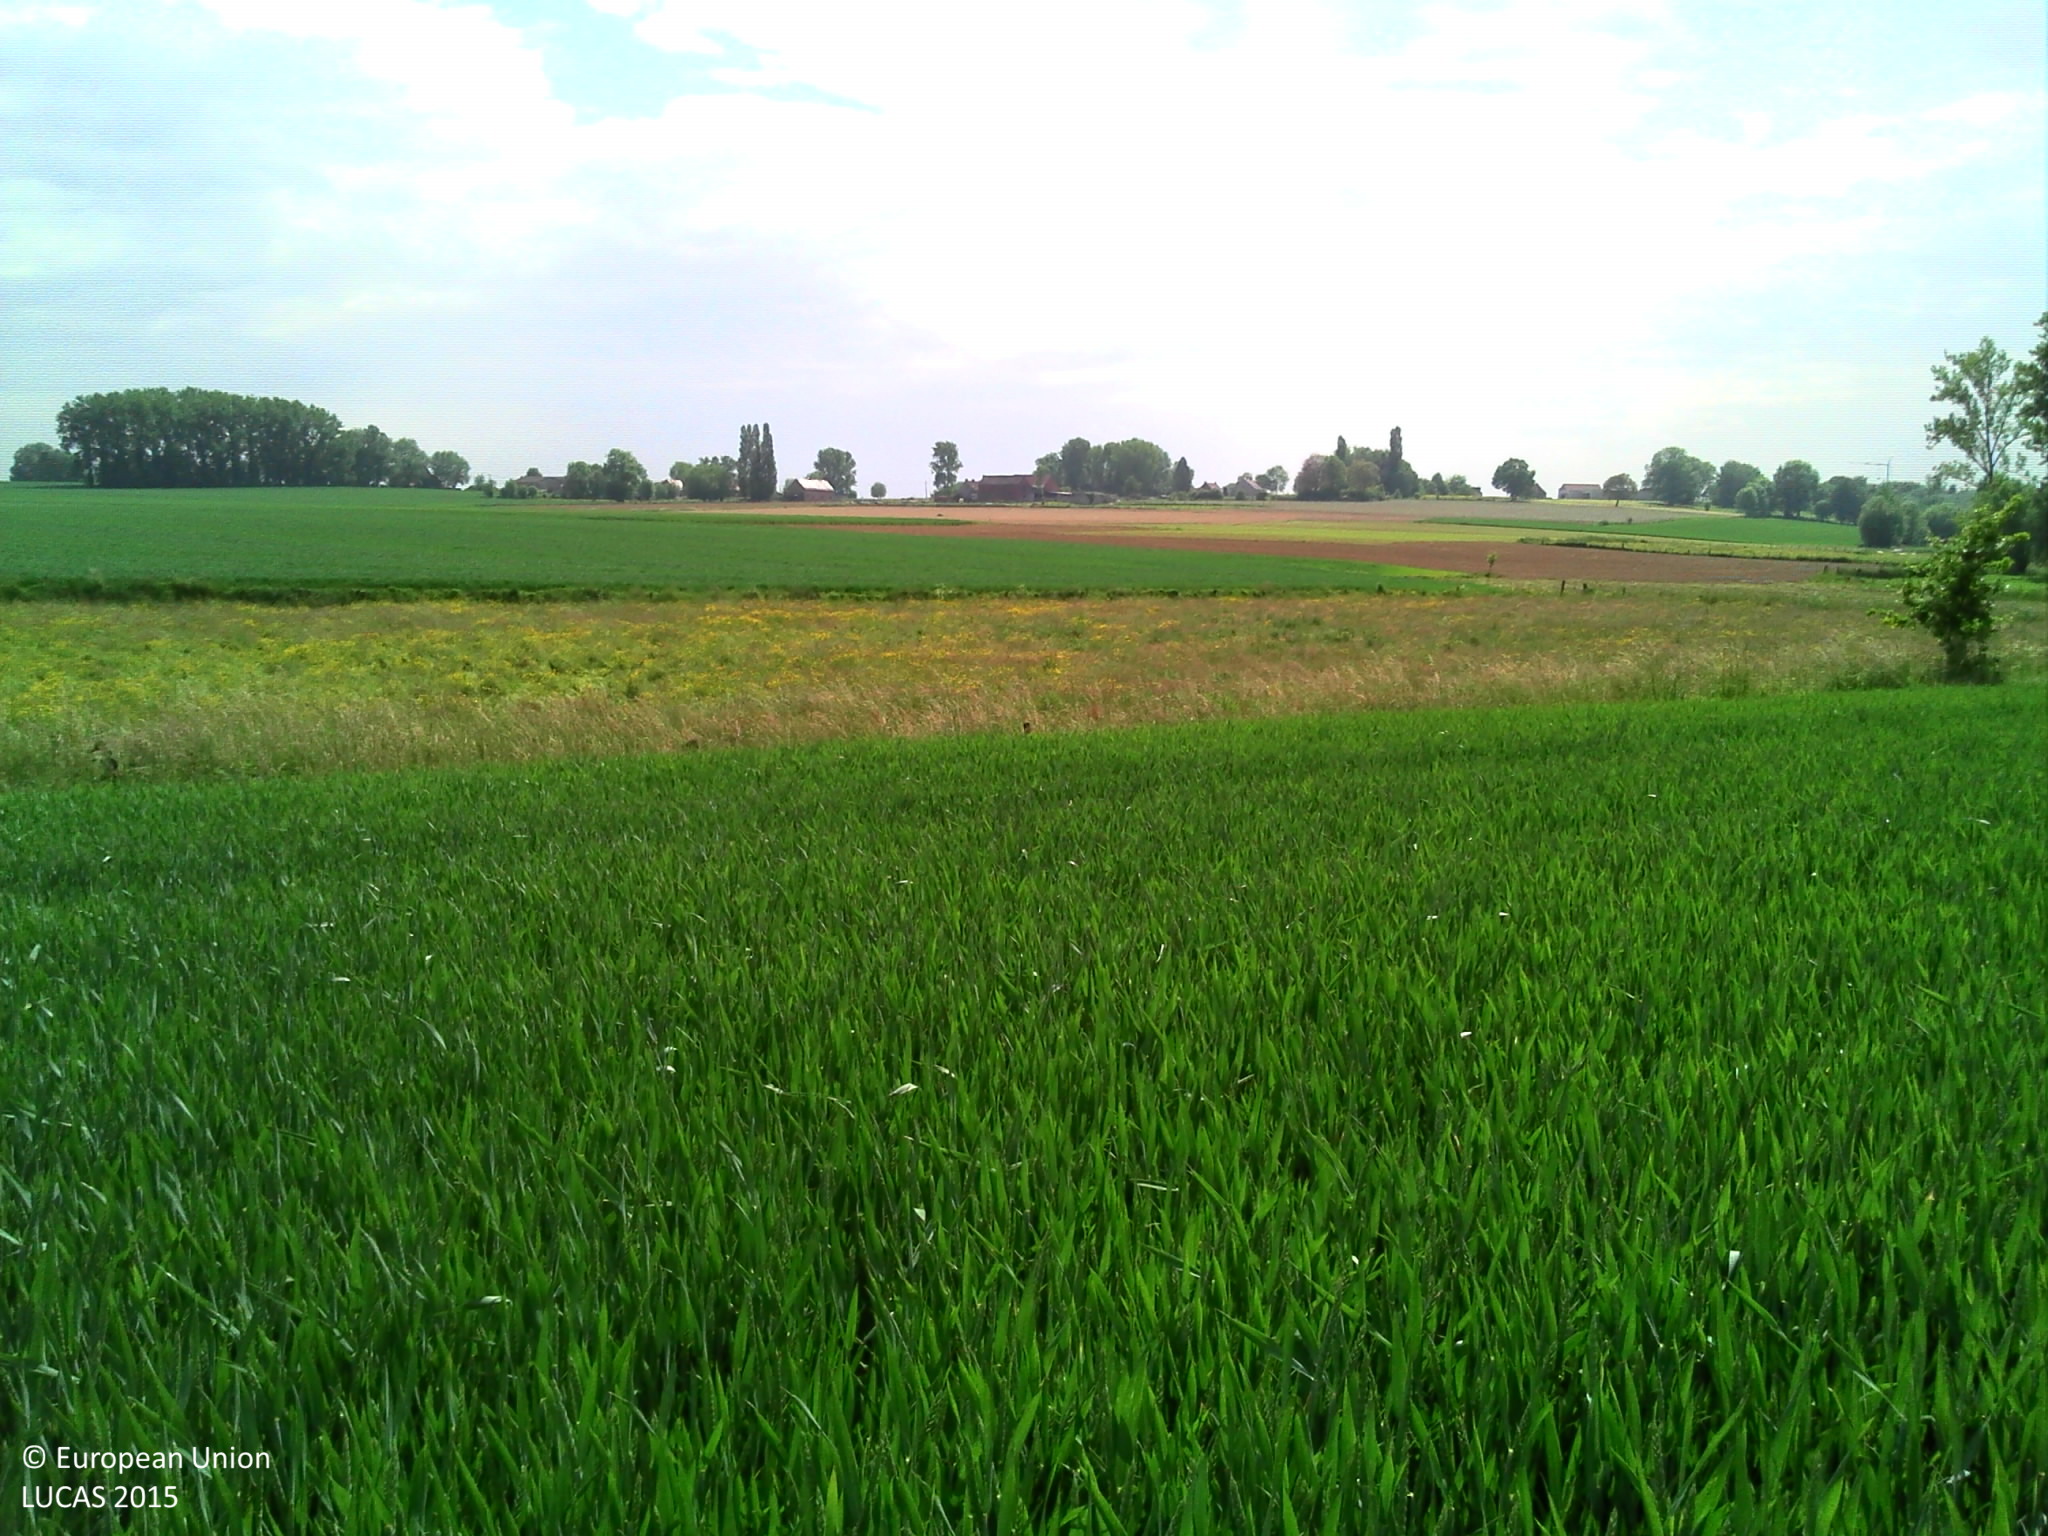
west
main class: Cropland
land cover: Common wheat
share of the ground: > 75 %
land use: Agriculture (excluding fallow land and kitchen gardens)
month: May
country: BE
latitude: 50.7116
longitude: 4.0037
